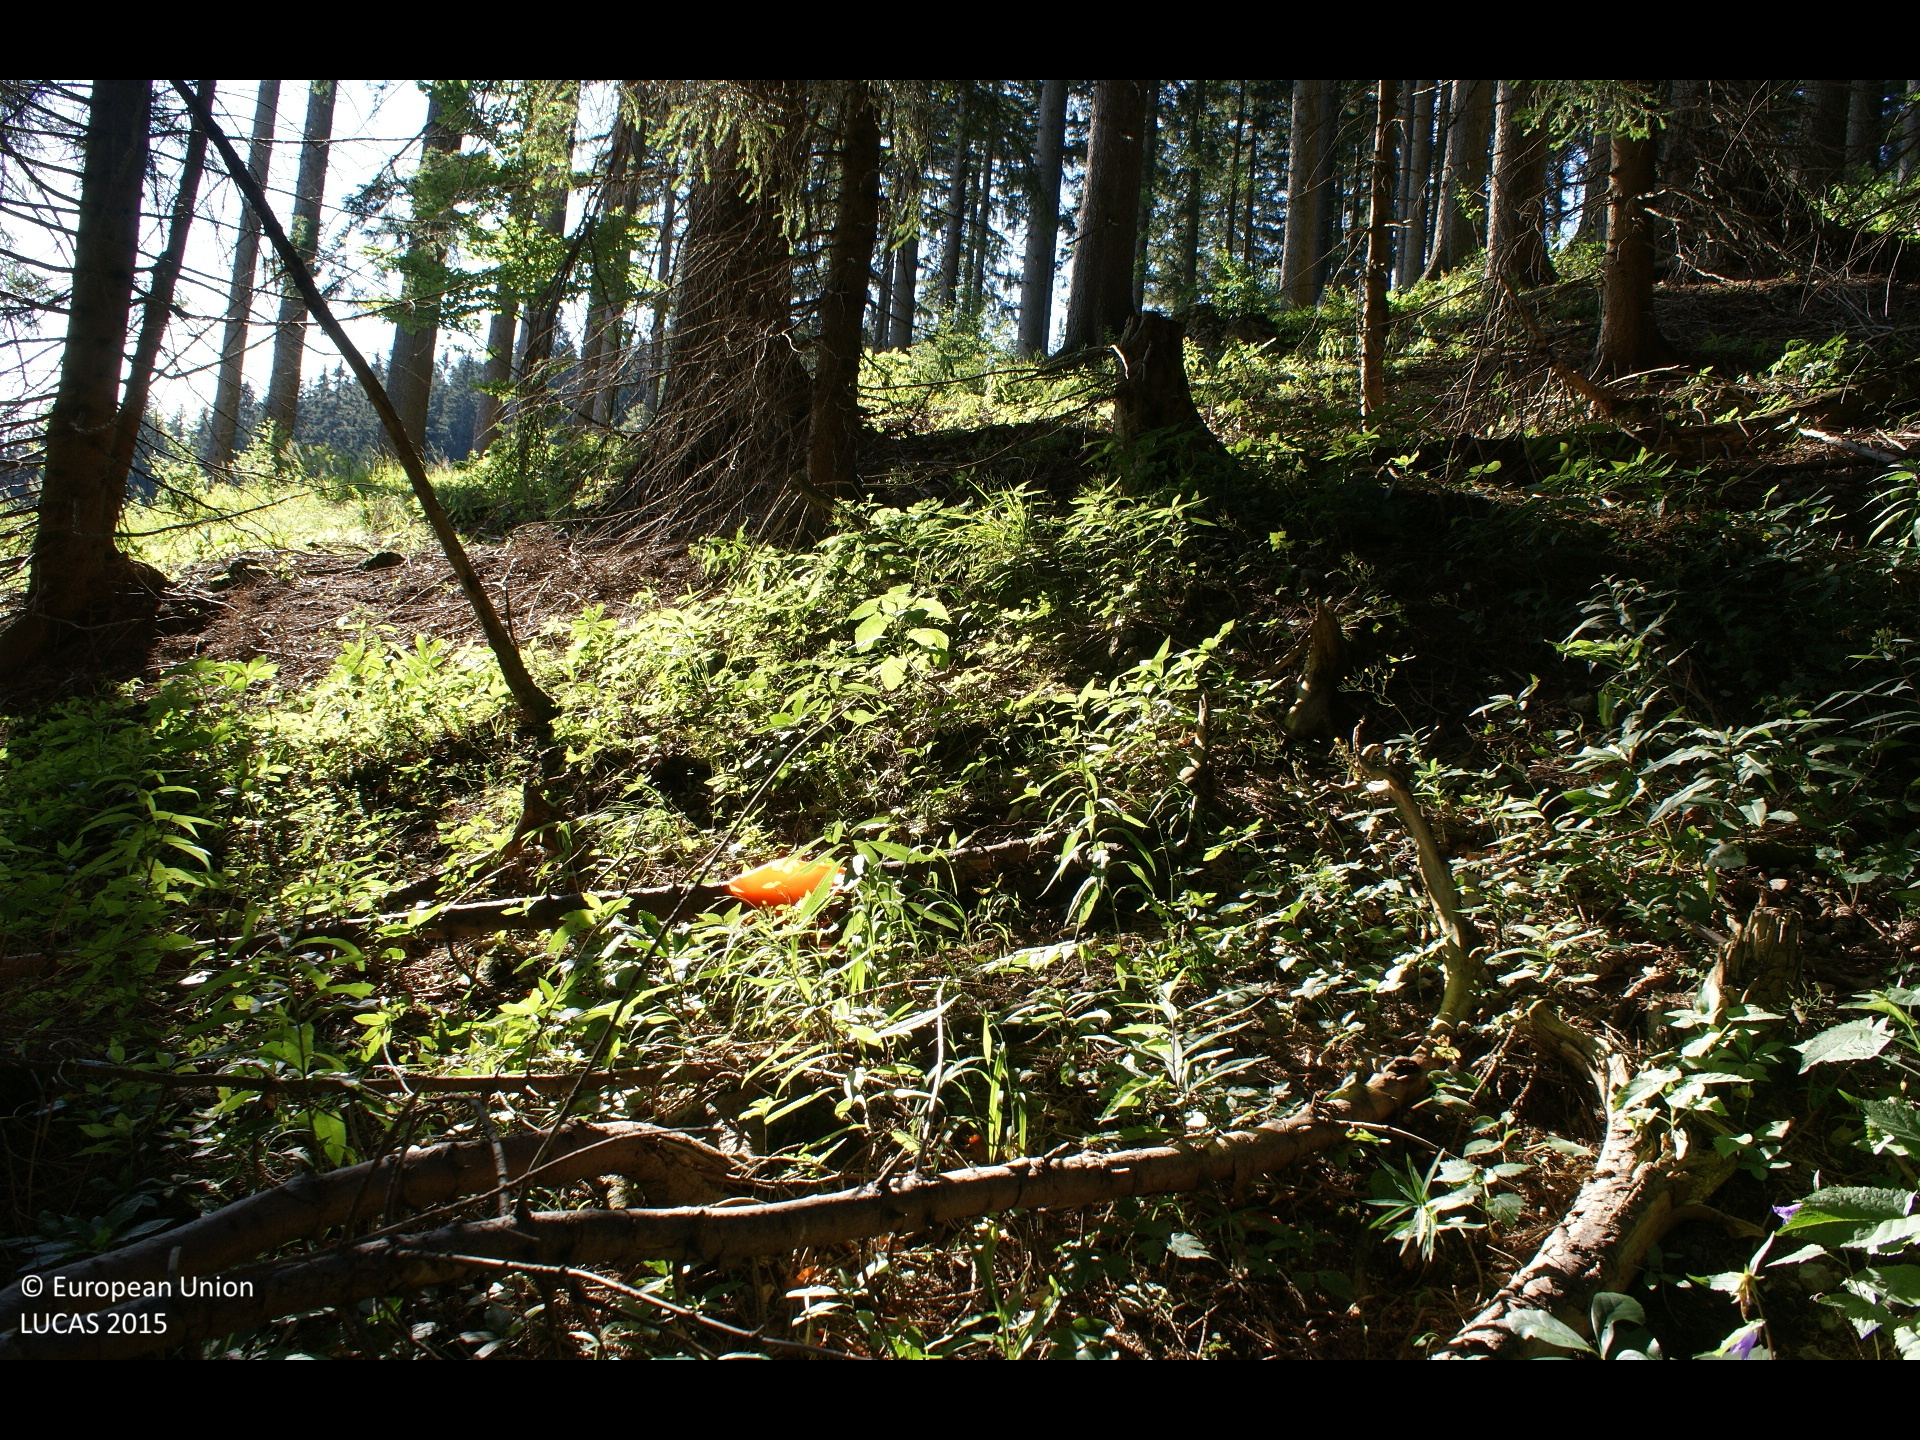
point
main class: Woodland
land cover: Spruce dominated coniferous woodland
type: alpine coniferous forest
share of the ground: > 75 %
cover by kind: coniferous forest trees 80 %, herbaceous plants 20 %
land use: Forestry
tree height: > 5 m
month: July
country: AT
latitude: 47.8984
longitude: 15.2849
